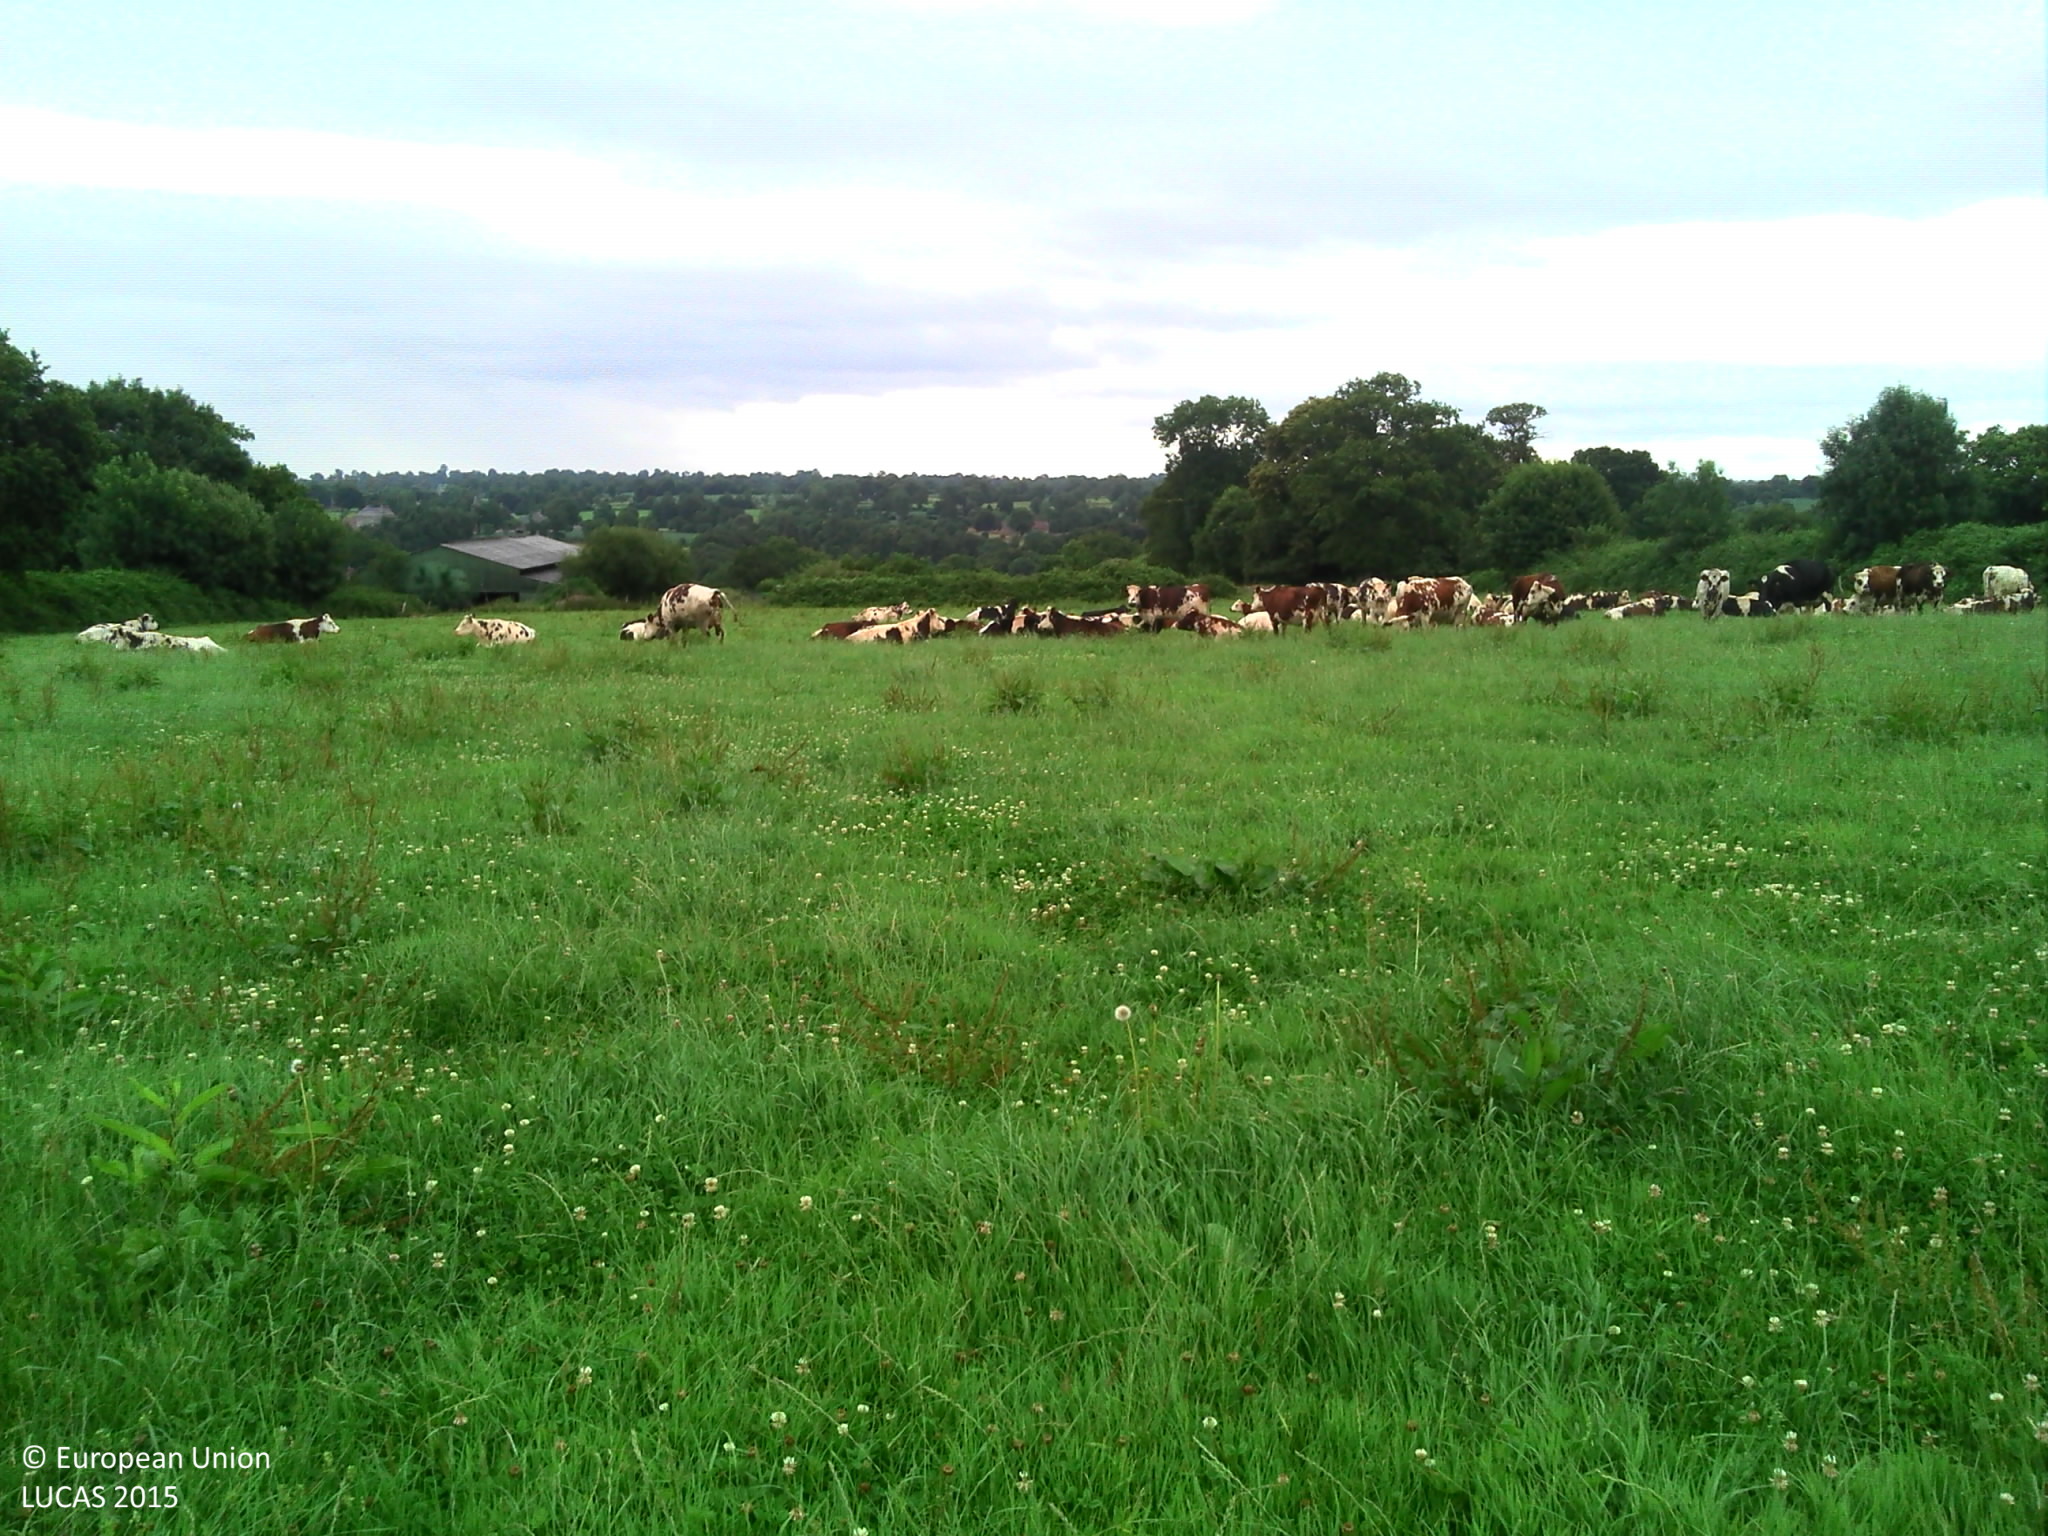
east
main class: Grassland
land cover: Grassland without tree/shrub cover
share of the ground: > 75 %
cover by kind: herbaceous plants 100 %
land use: Agriculture (excluding fallow land and kitchen gardens)
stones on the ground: < 10 %
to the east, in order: Grassland without tree/shrub cover; Managed hedges; Grassland without tree/shrub cover; Tracks; Grassland without tree/shrub cover; Fences; Grassland without tree/shrub cover; Artificial constructions in urban areas; Other bare soil; Spontaneously vegetated surfaces; Abandoned hedges; Grassland without tree/shrub cover
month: July
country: FR
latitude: 48.8503
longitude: -1.3712
